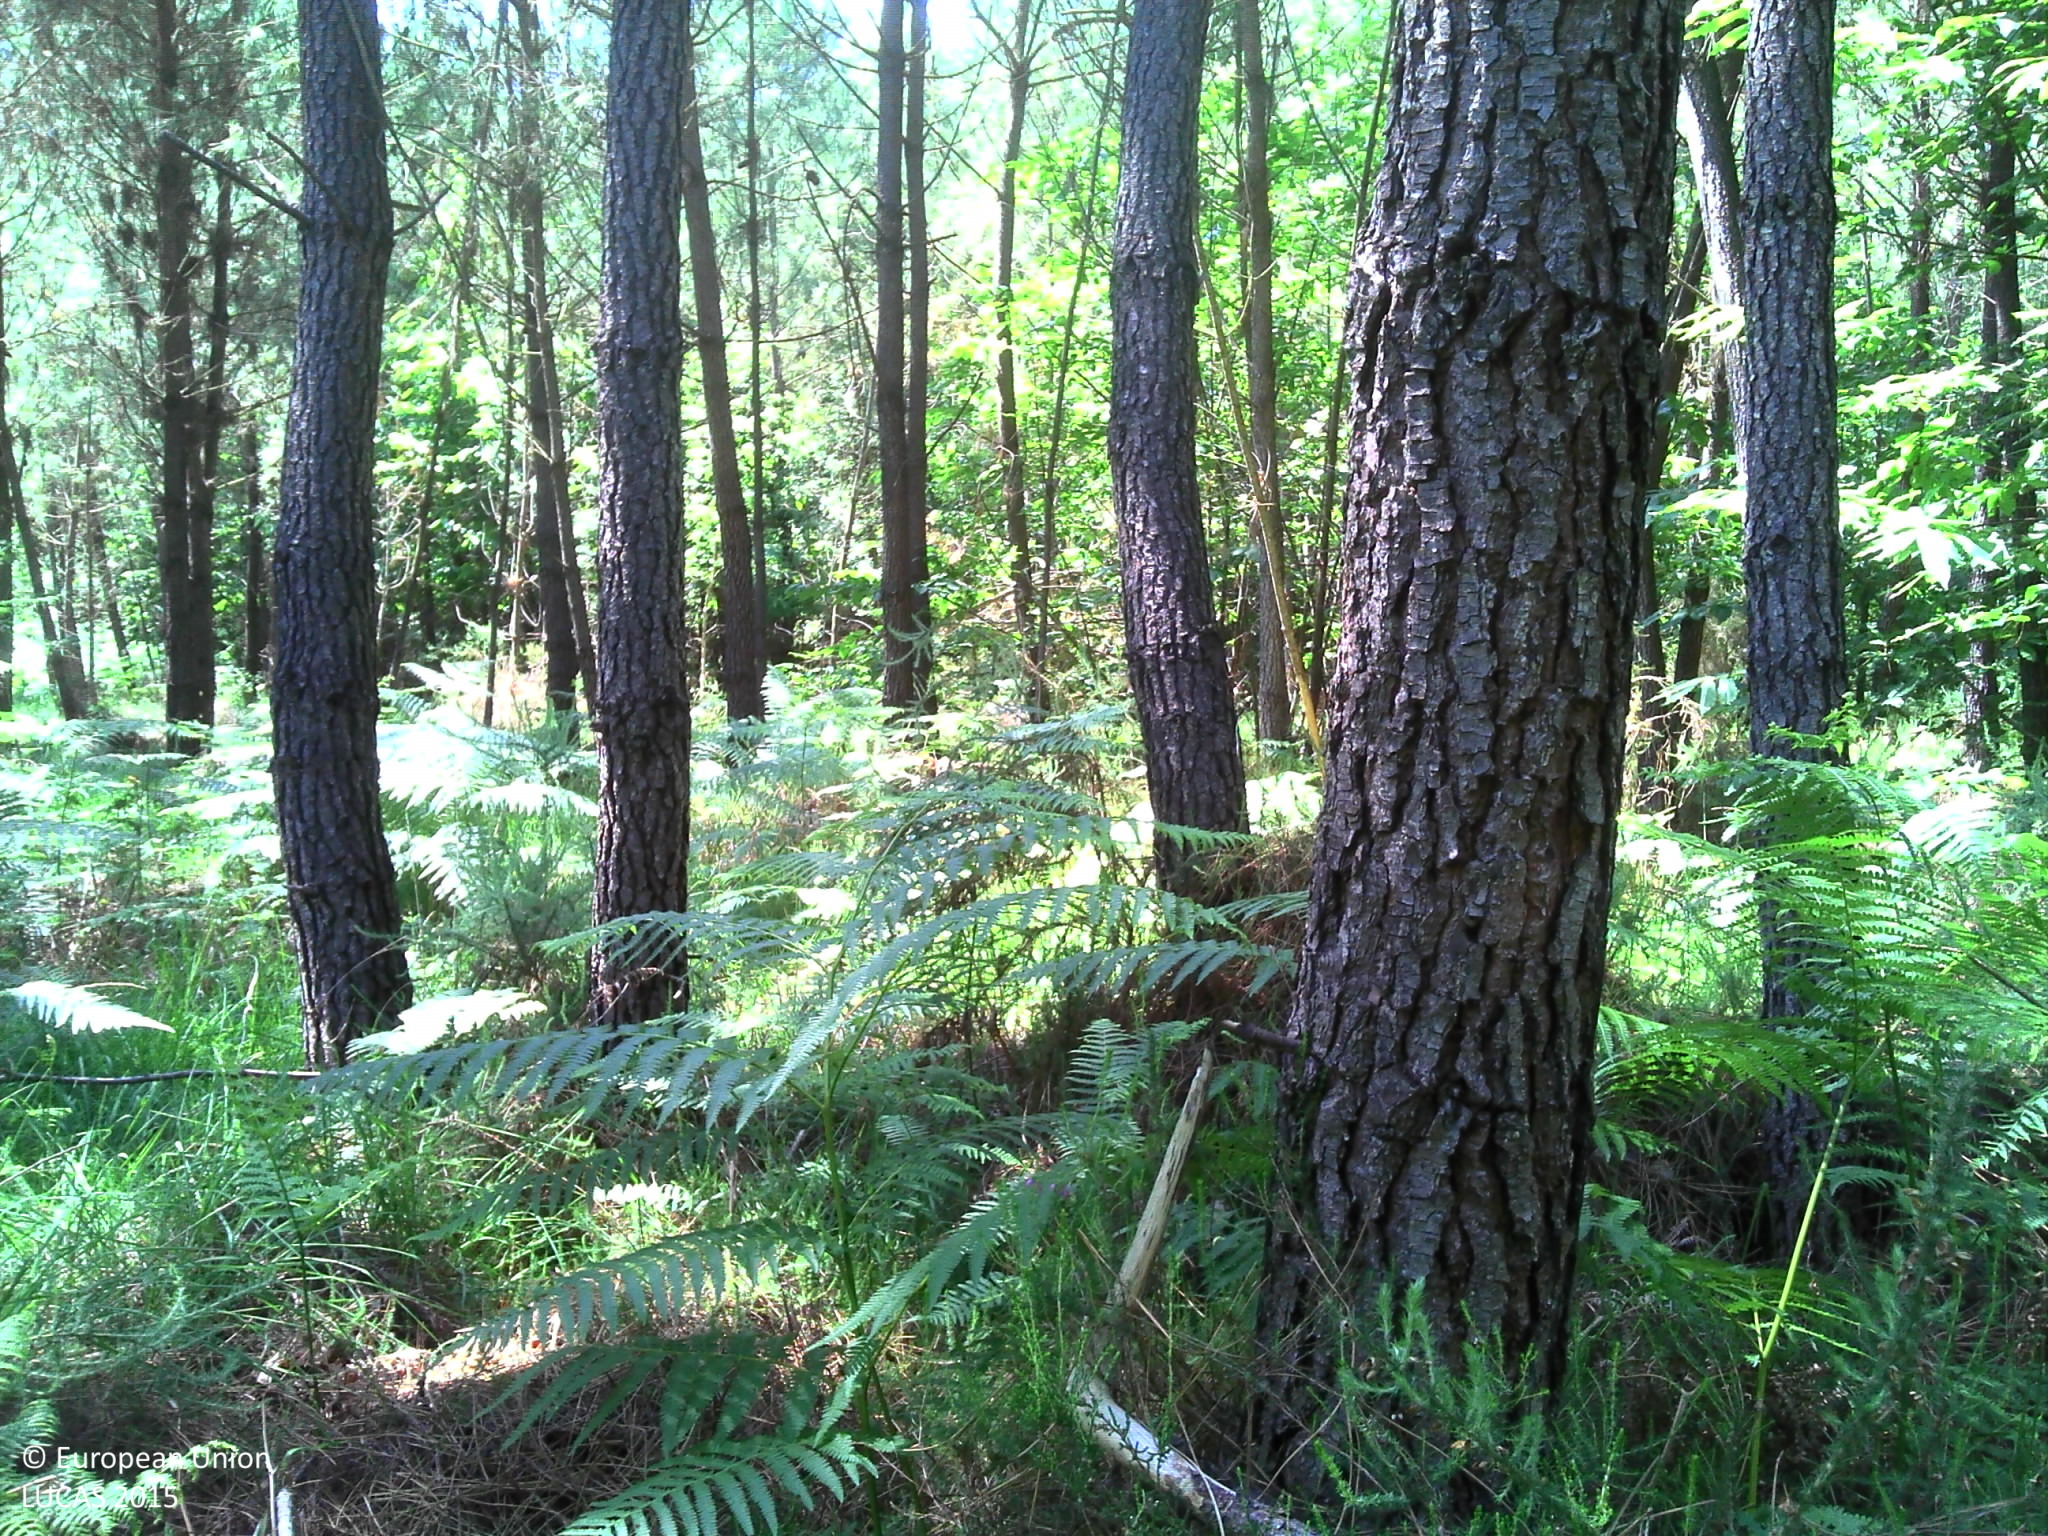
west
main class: Woodland
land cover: Pine dominated mixed woodland
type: hemiboreal forest and nemoral coniferous forest and mixed broadleaved-coniferous forest
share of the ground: > 75 %
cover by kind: broadleaved forest trees 40 %, coniferous forest trees 30 %, herbaceous plants 20 %, lichens and mosses 10 %
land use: Forestry
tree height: > 5 m
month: June
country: FR
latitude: 47.3205
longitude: 0.0659
